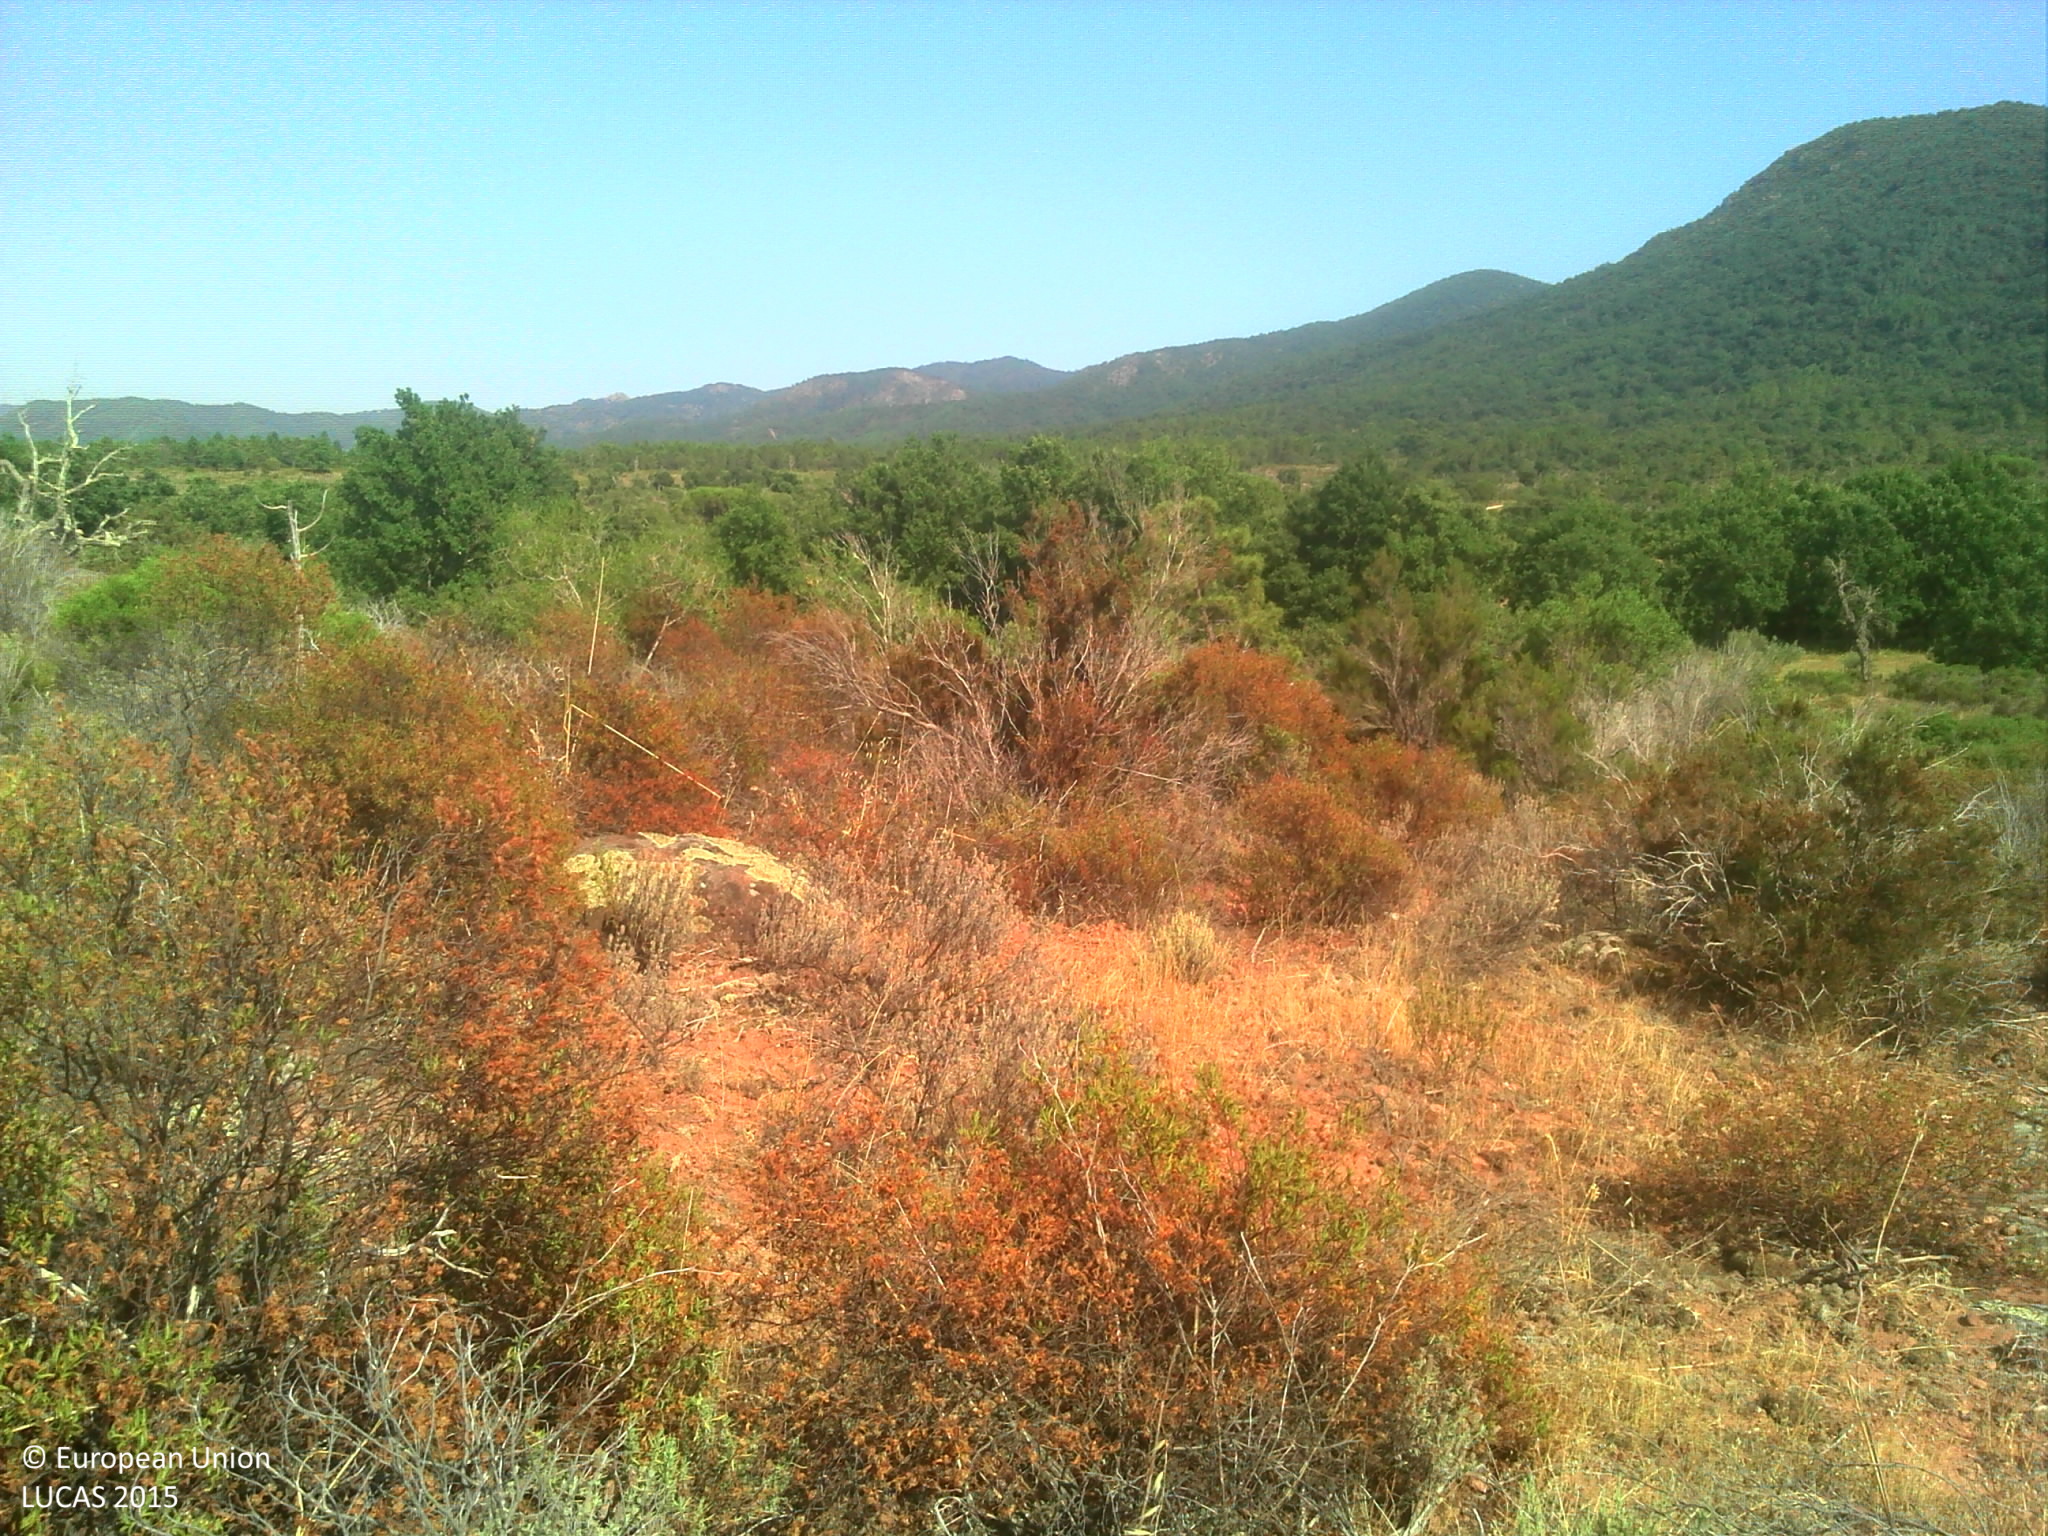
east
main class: Shrubland
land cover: Shrubland without tree cover
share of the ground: > 75 %
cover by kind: shrubs 100 %
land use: Semi-natural and natural areas not in use
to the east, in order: Shrubland without tree cover; Rock outcrops; Shrubland without tree cover; Rock outcrops; Shrubland without tree cover; Rock outcrops; Grassland with sparse tree/shrub cover; Abandoned hedges; Rivers and streams; Floriculture and ornamental plants; Ditches and canals; Electric lines; Abandoned hedges; Olive groves
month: July
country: FR
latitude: 43.3300
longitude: 6.3709
